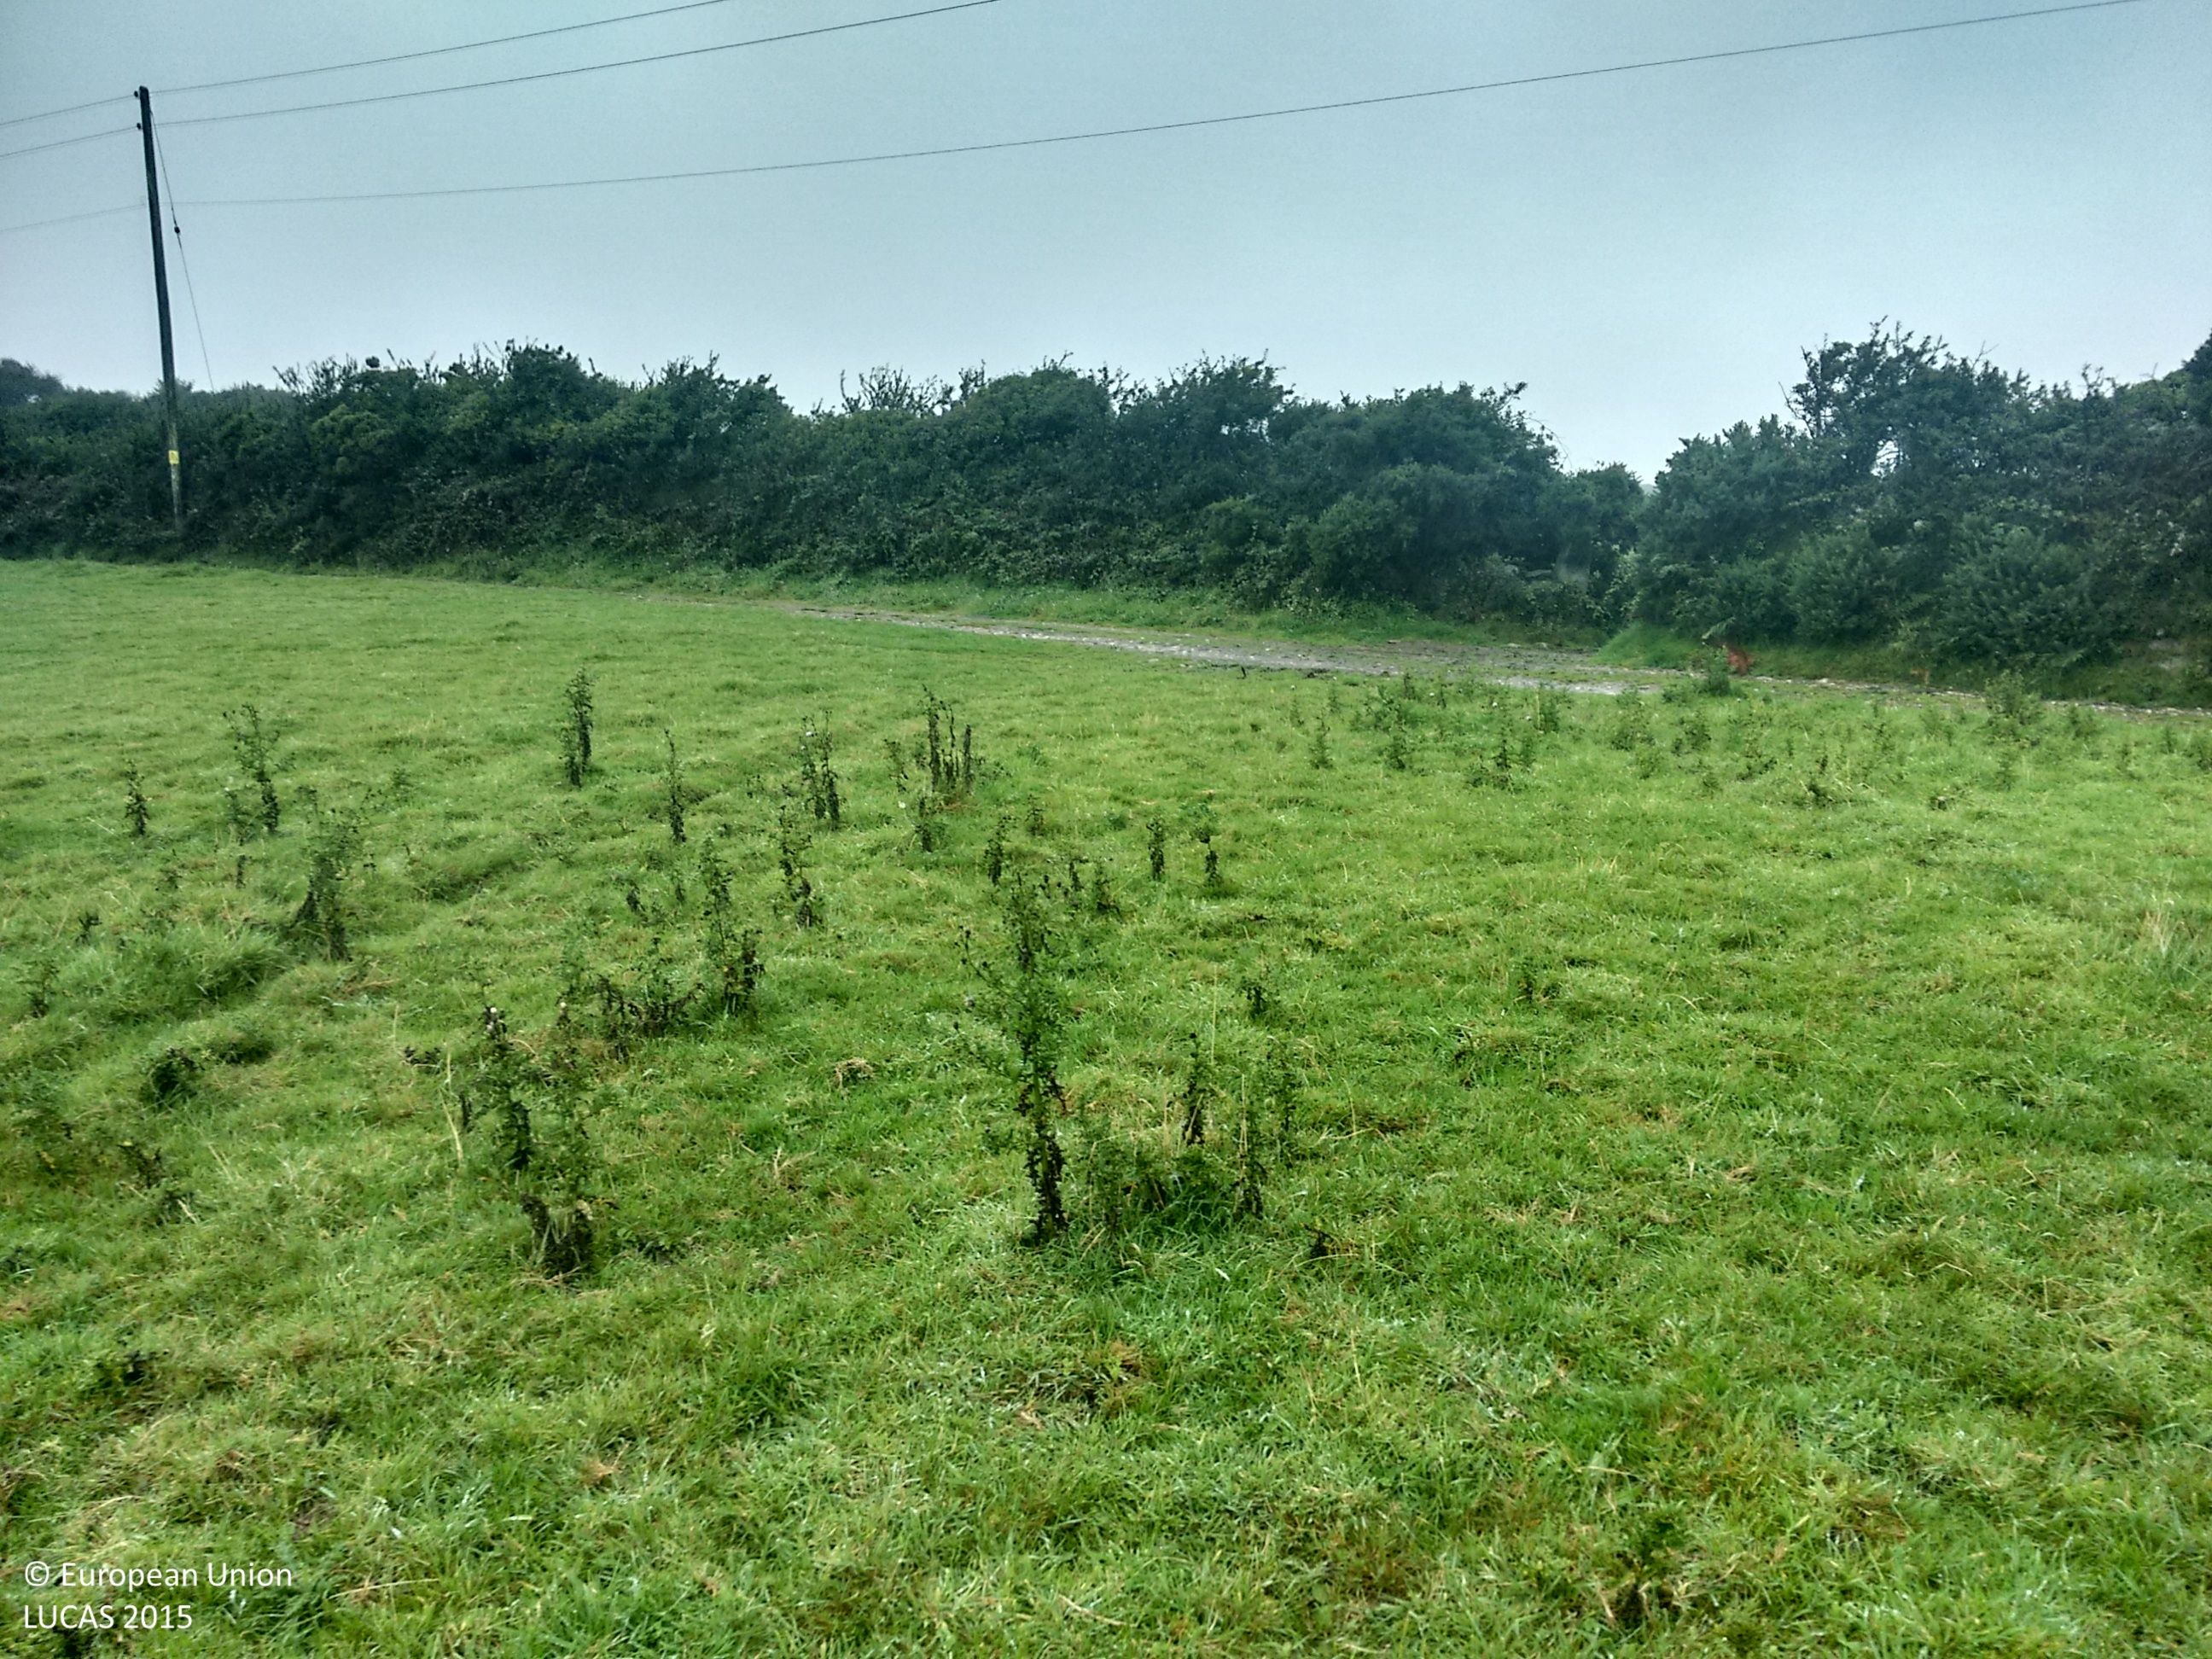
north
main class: Grassland
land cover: Grassland without tree/shrub cover
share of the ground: > 75 %
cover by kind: herbaceous plants 100 %
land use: Agriculture (excluding fallow land and kitchen gardens)
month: August
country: GB
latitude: 50.1255
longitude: -5.2131
